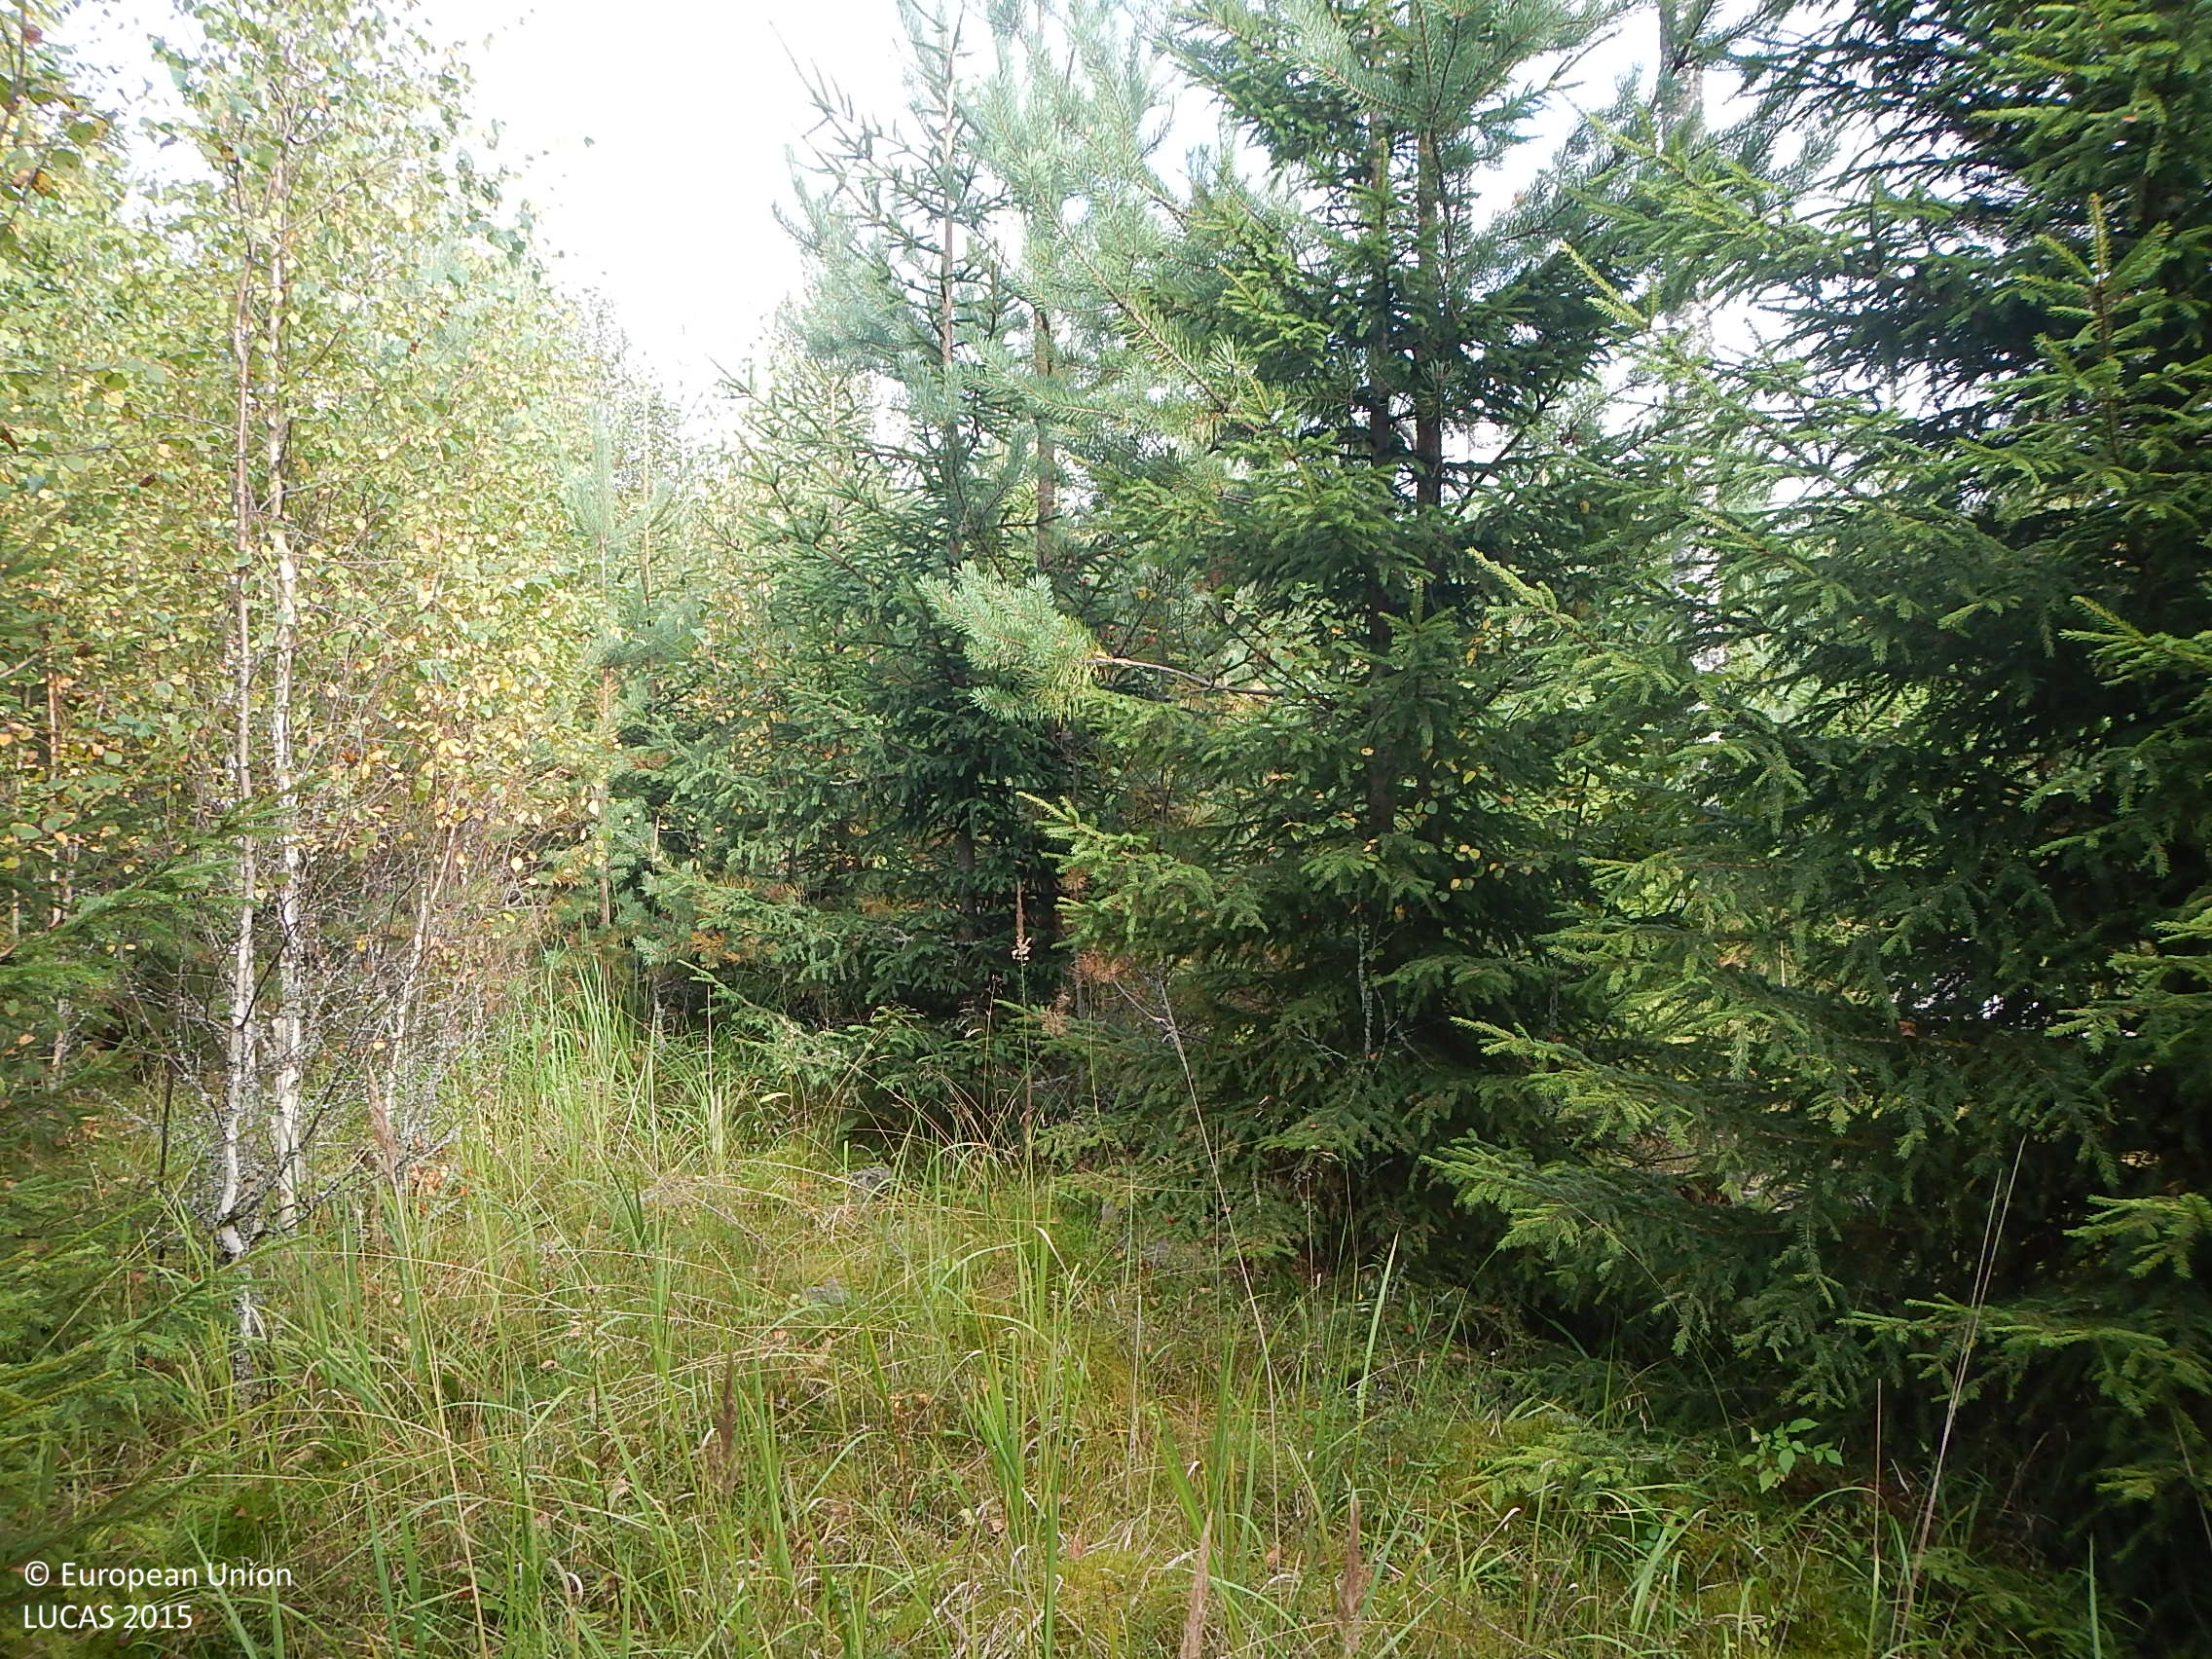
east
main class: Woodland
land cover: Other mixed woodland
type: boreal forest
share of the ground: > 75 %
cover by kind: coniferous forest trees 40 %, broadleaved forest trees 40 %, herbaceous plants 15 %, lichens and mosses 5 %
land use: Forestry
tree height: < 5 m
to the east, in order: Other mixed woodland; Rock outcrops; Broadleaved woodland; Ditches and canals; Grass margins; Oats; Grass margins; Ditches and canals; Broadleaved woodland
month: September
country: FI
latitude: 61.4507
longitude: 22.6901
